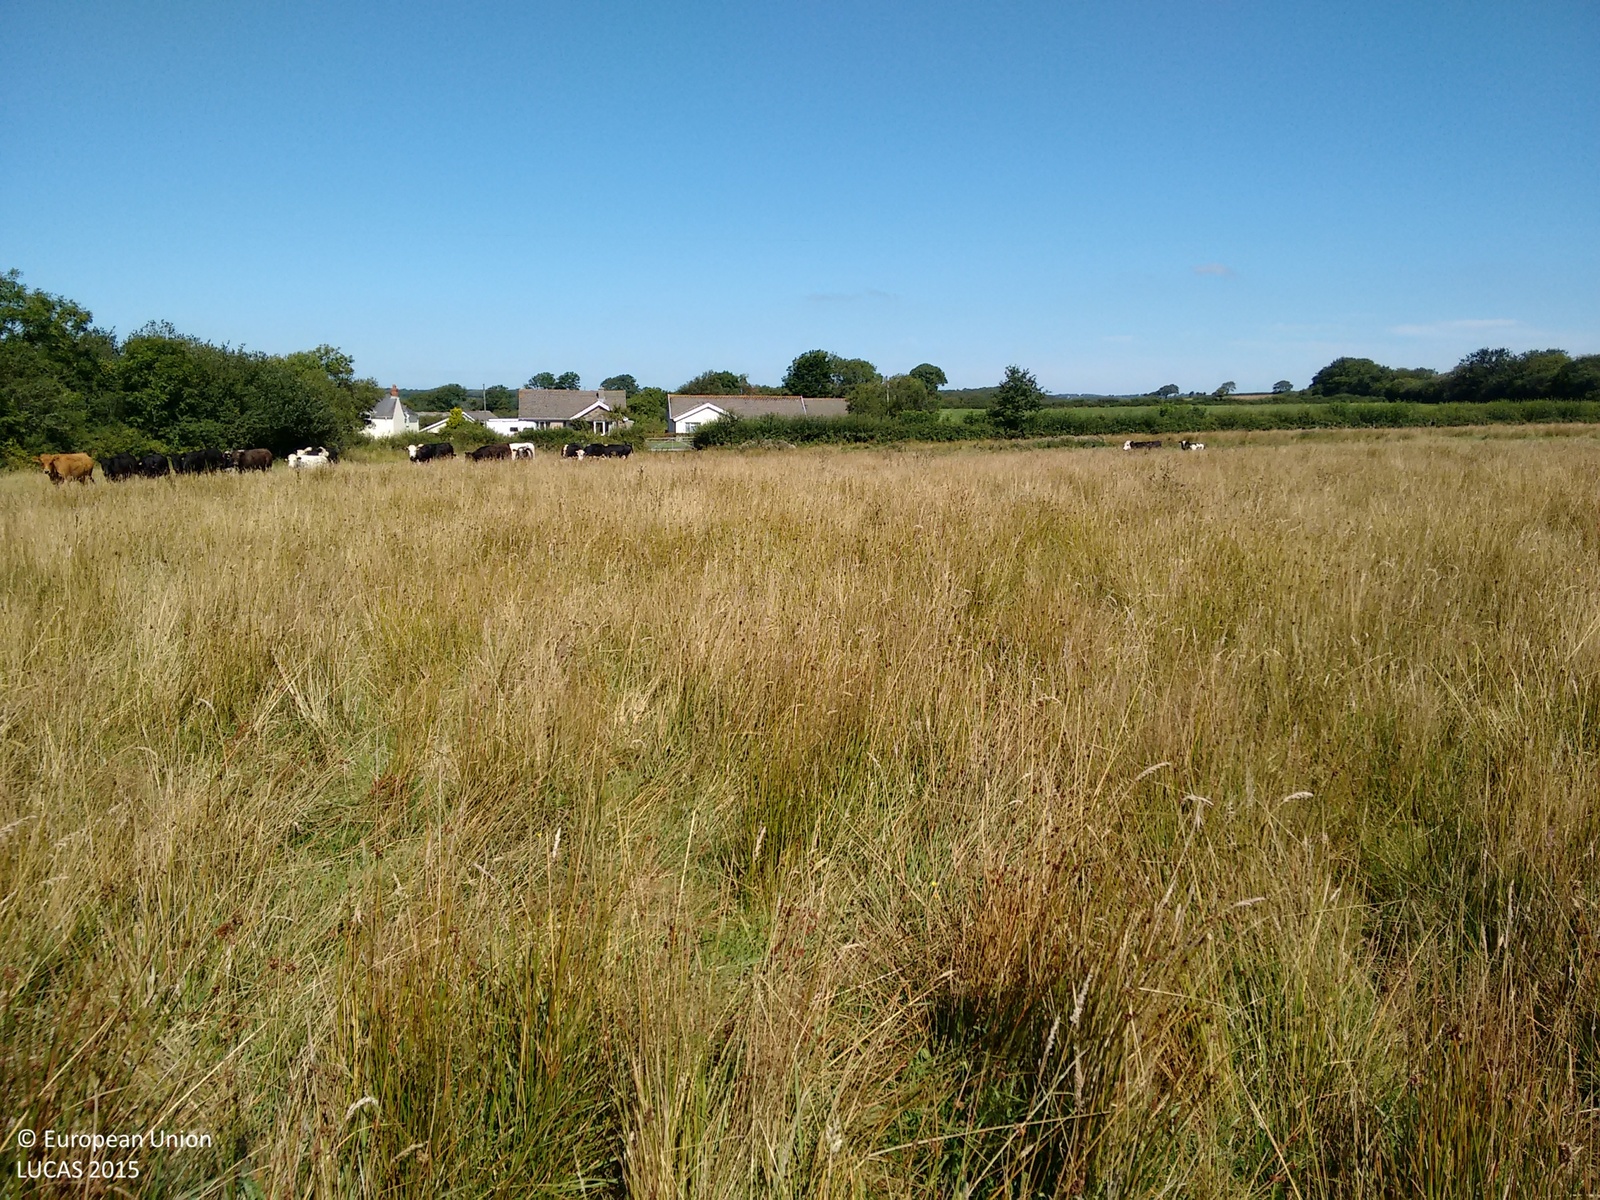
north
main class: Grassland
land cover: Grassland without tree/shrub cover
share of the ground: > 75 %
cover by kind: herbaceous plants 100 %
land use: Agriculture (excluding fallow land and kitchen gardens)
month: August
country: GB
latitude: 51.7129
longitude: -4.8323
